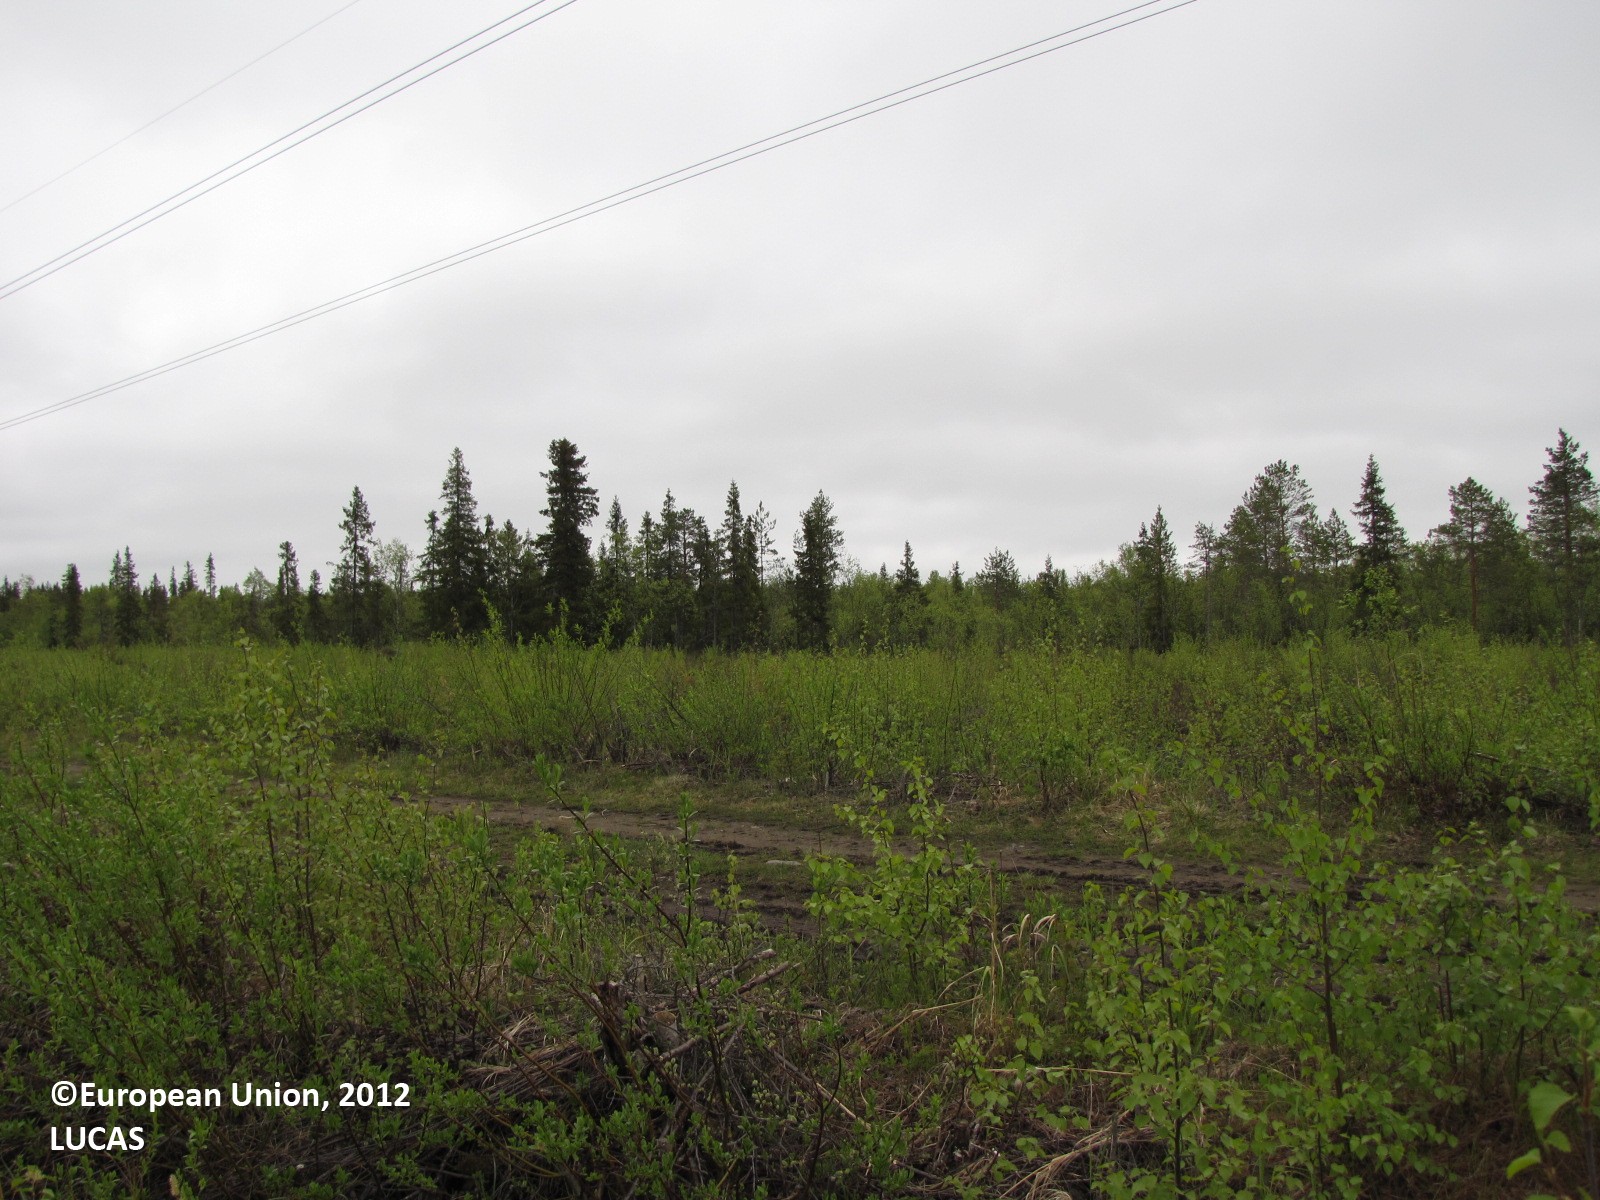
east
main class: Shrubland
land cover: Shrubland with sparse tree cover
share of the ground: > 75 %
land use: Energy production
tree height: < 5 m
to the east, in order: Shrubland with sparse tree cover; Electric lines; Shrubland with sparse tree cover; Paved roads, cycling and walking lanes; Ditches and canals; Shrubland with sparse tree cover; Electric lines; Shrubland with sparse tree cover; Other mixed woodland; Ditches and canals; Spruce dominated mixed woodland; Ditches and canals; Spruce dominated mixed woodland; Ditches and canals; Other mixed woodland; Ditches and canals; Other mixed woodland; Spruce dominated mixed woodland
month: June
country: FI
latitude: 65.9610
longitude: 24.0579
